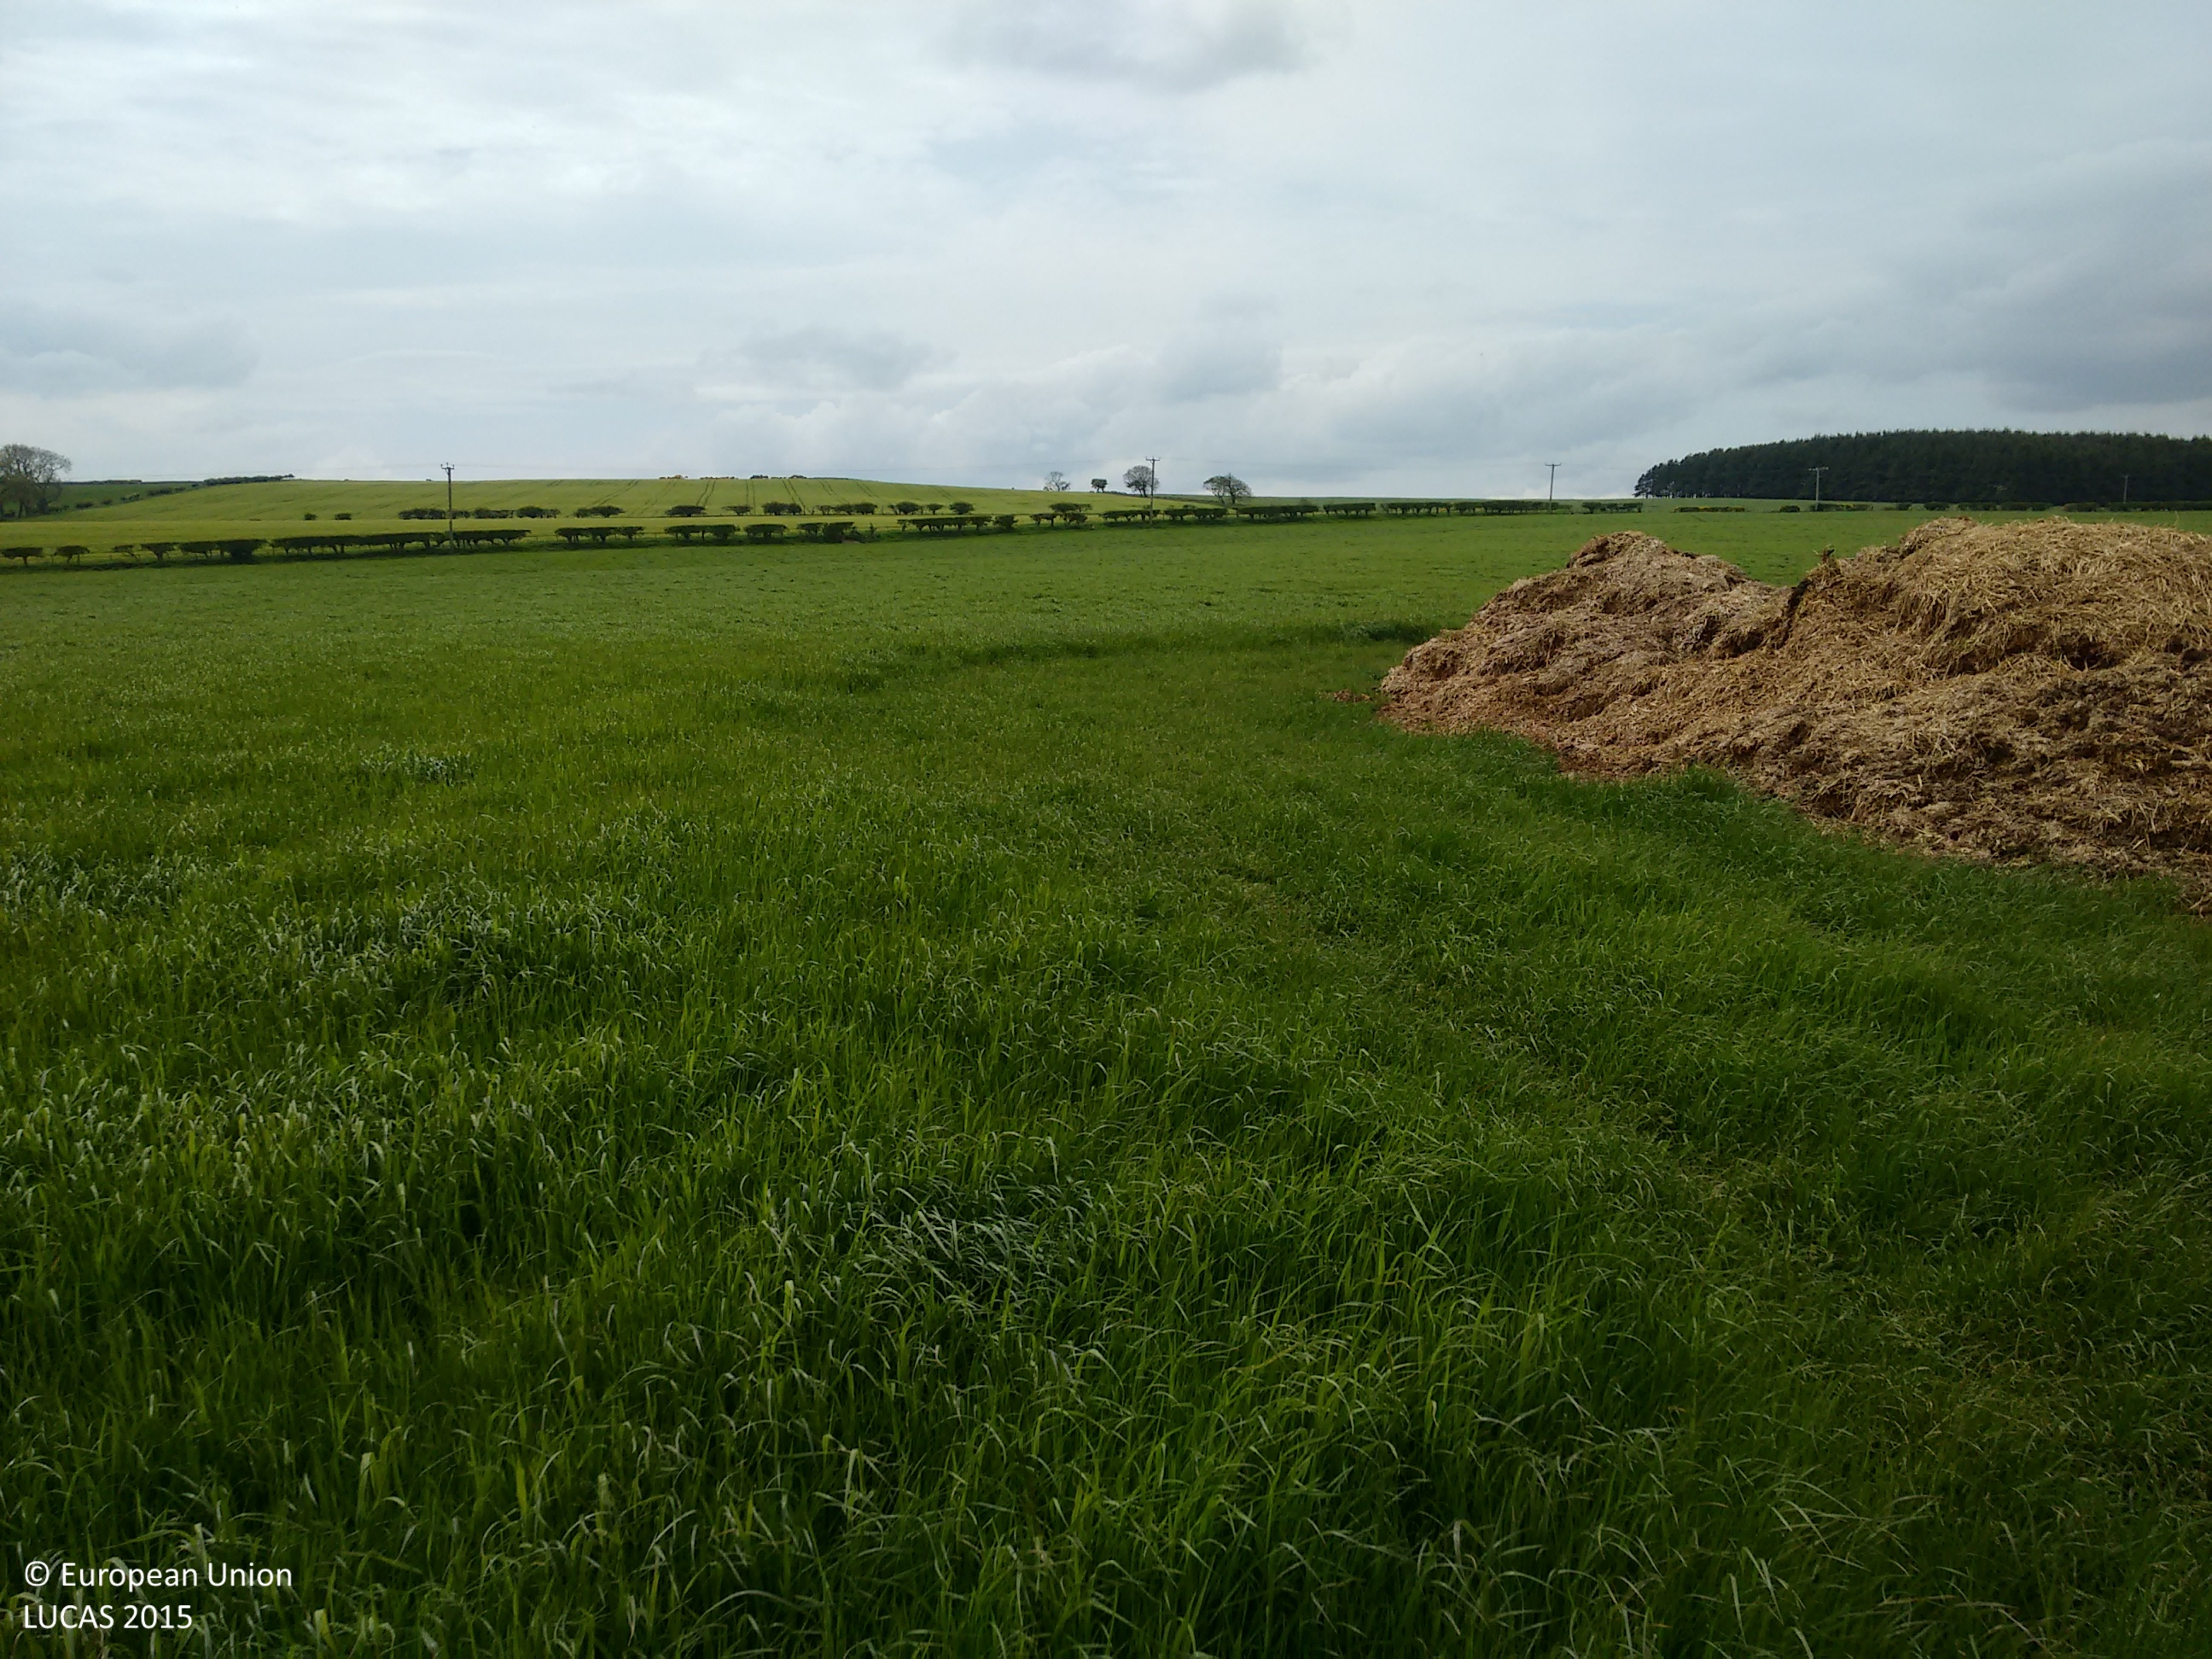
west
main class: Cropland
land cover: Temporary grasslands
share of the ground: > 75 %
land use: Agriculture (excluding fallow land and kitchen gardens)
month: June
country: GB
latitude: 55.4827
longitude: -1.7431
